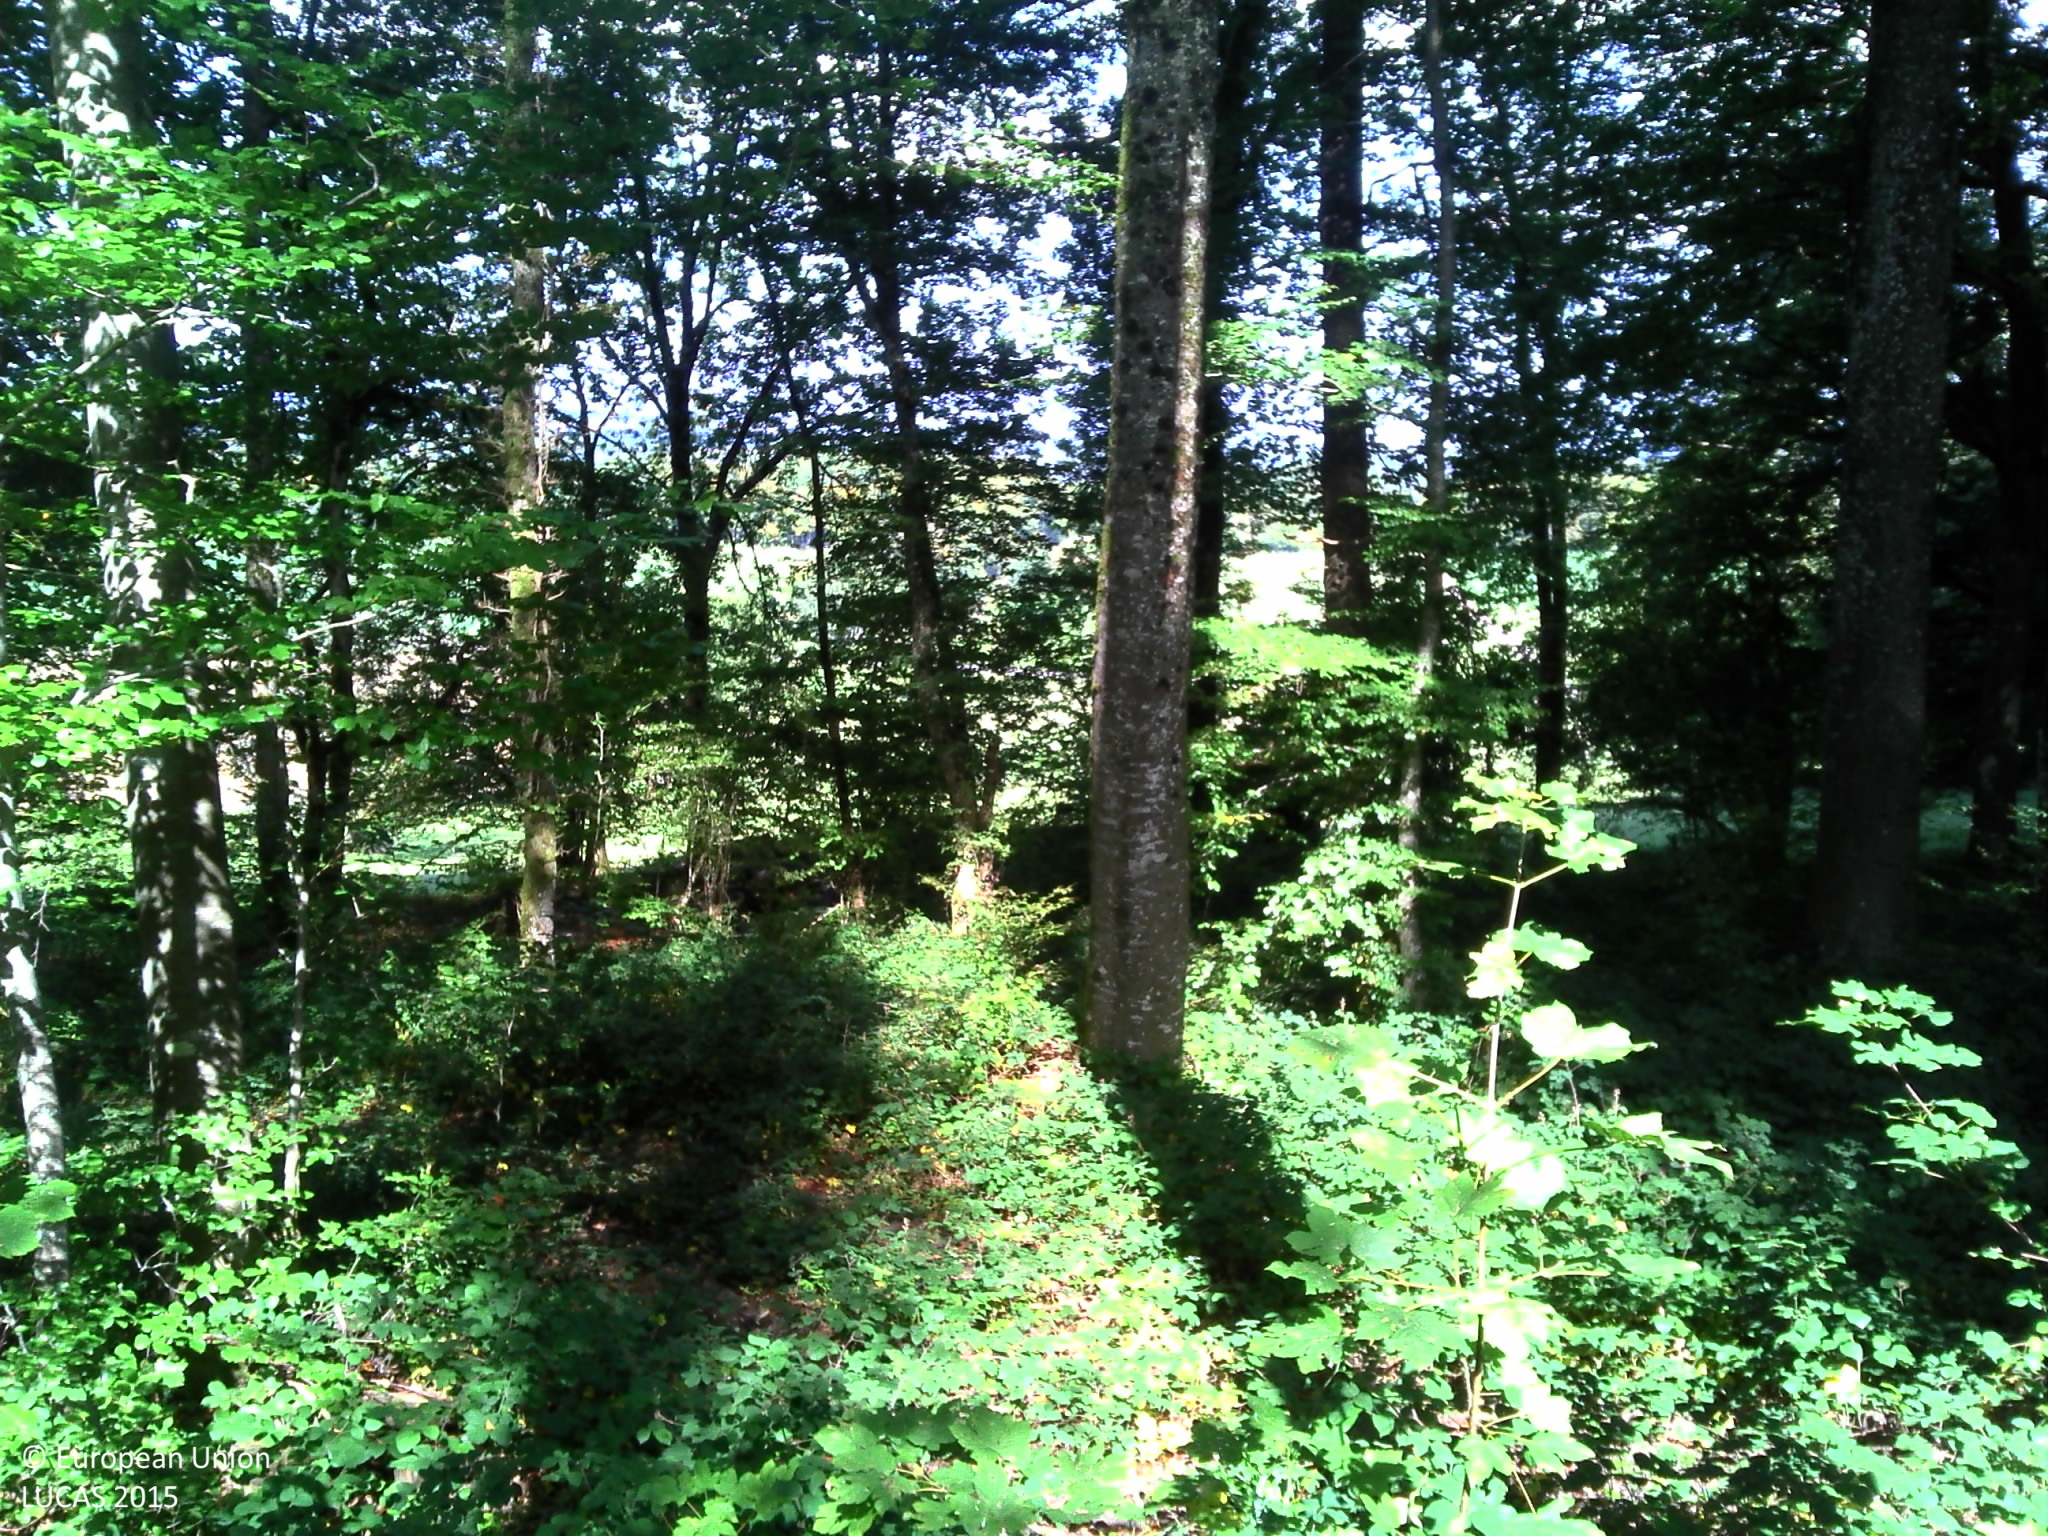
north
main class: Woodland
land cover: Broadleaved woodland
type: beech forest
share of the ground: > 75 %
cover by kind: broadleaved forest trees 80 %, shrubs 15 %, herbaceous plants 5 %
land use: Forestry
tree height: > 5 m
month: September
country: FR
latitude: 47.3684
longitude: 6.8635
